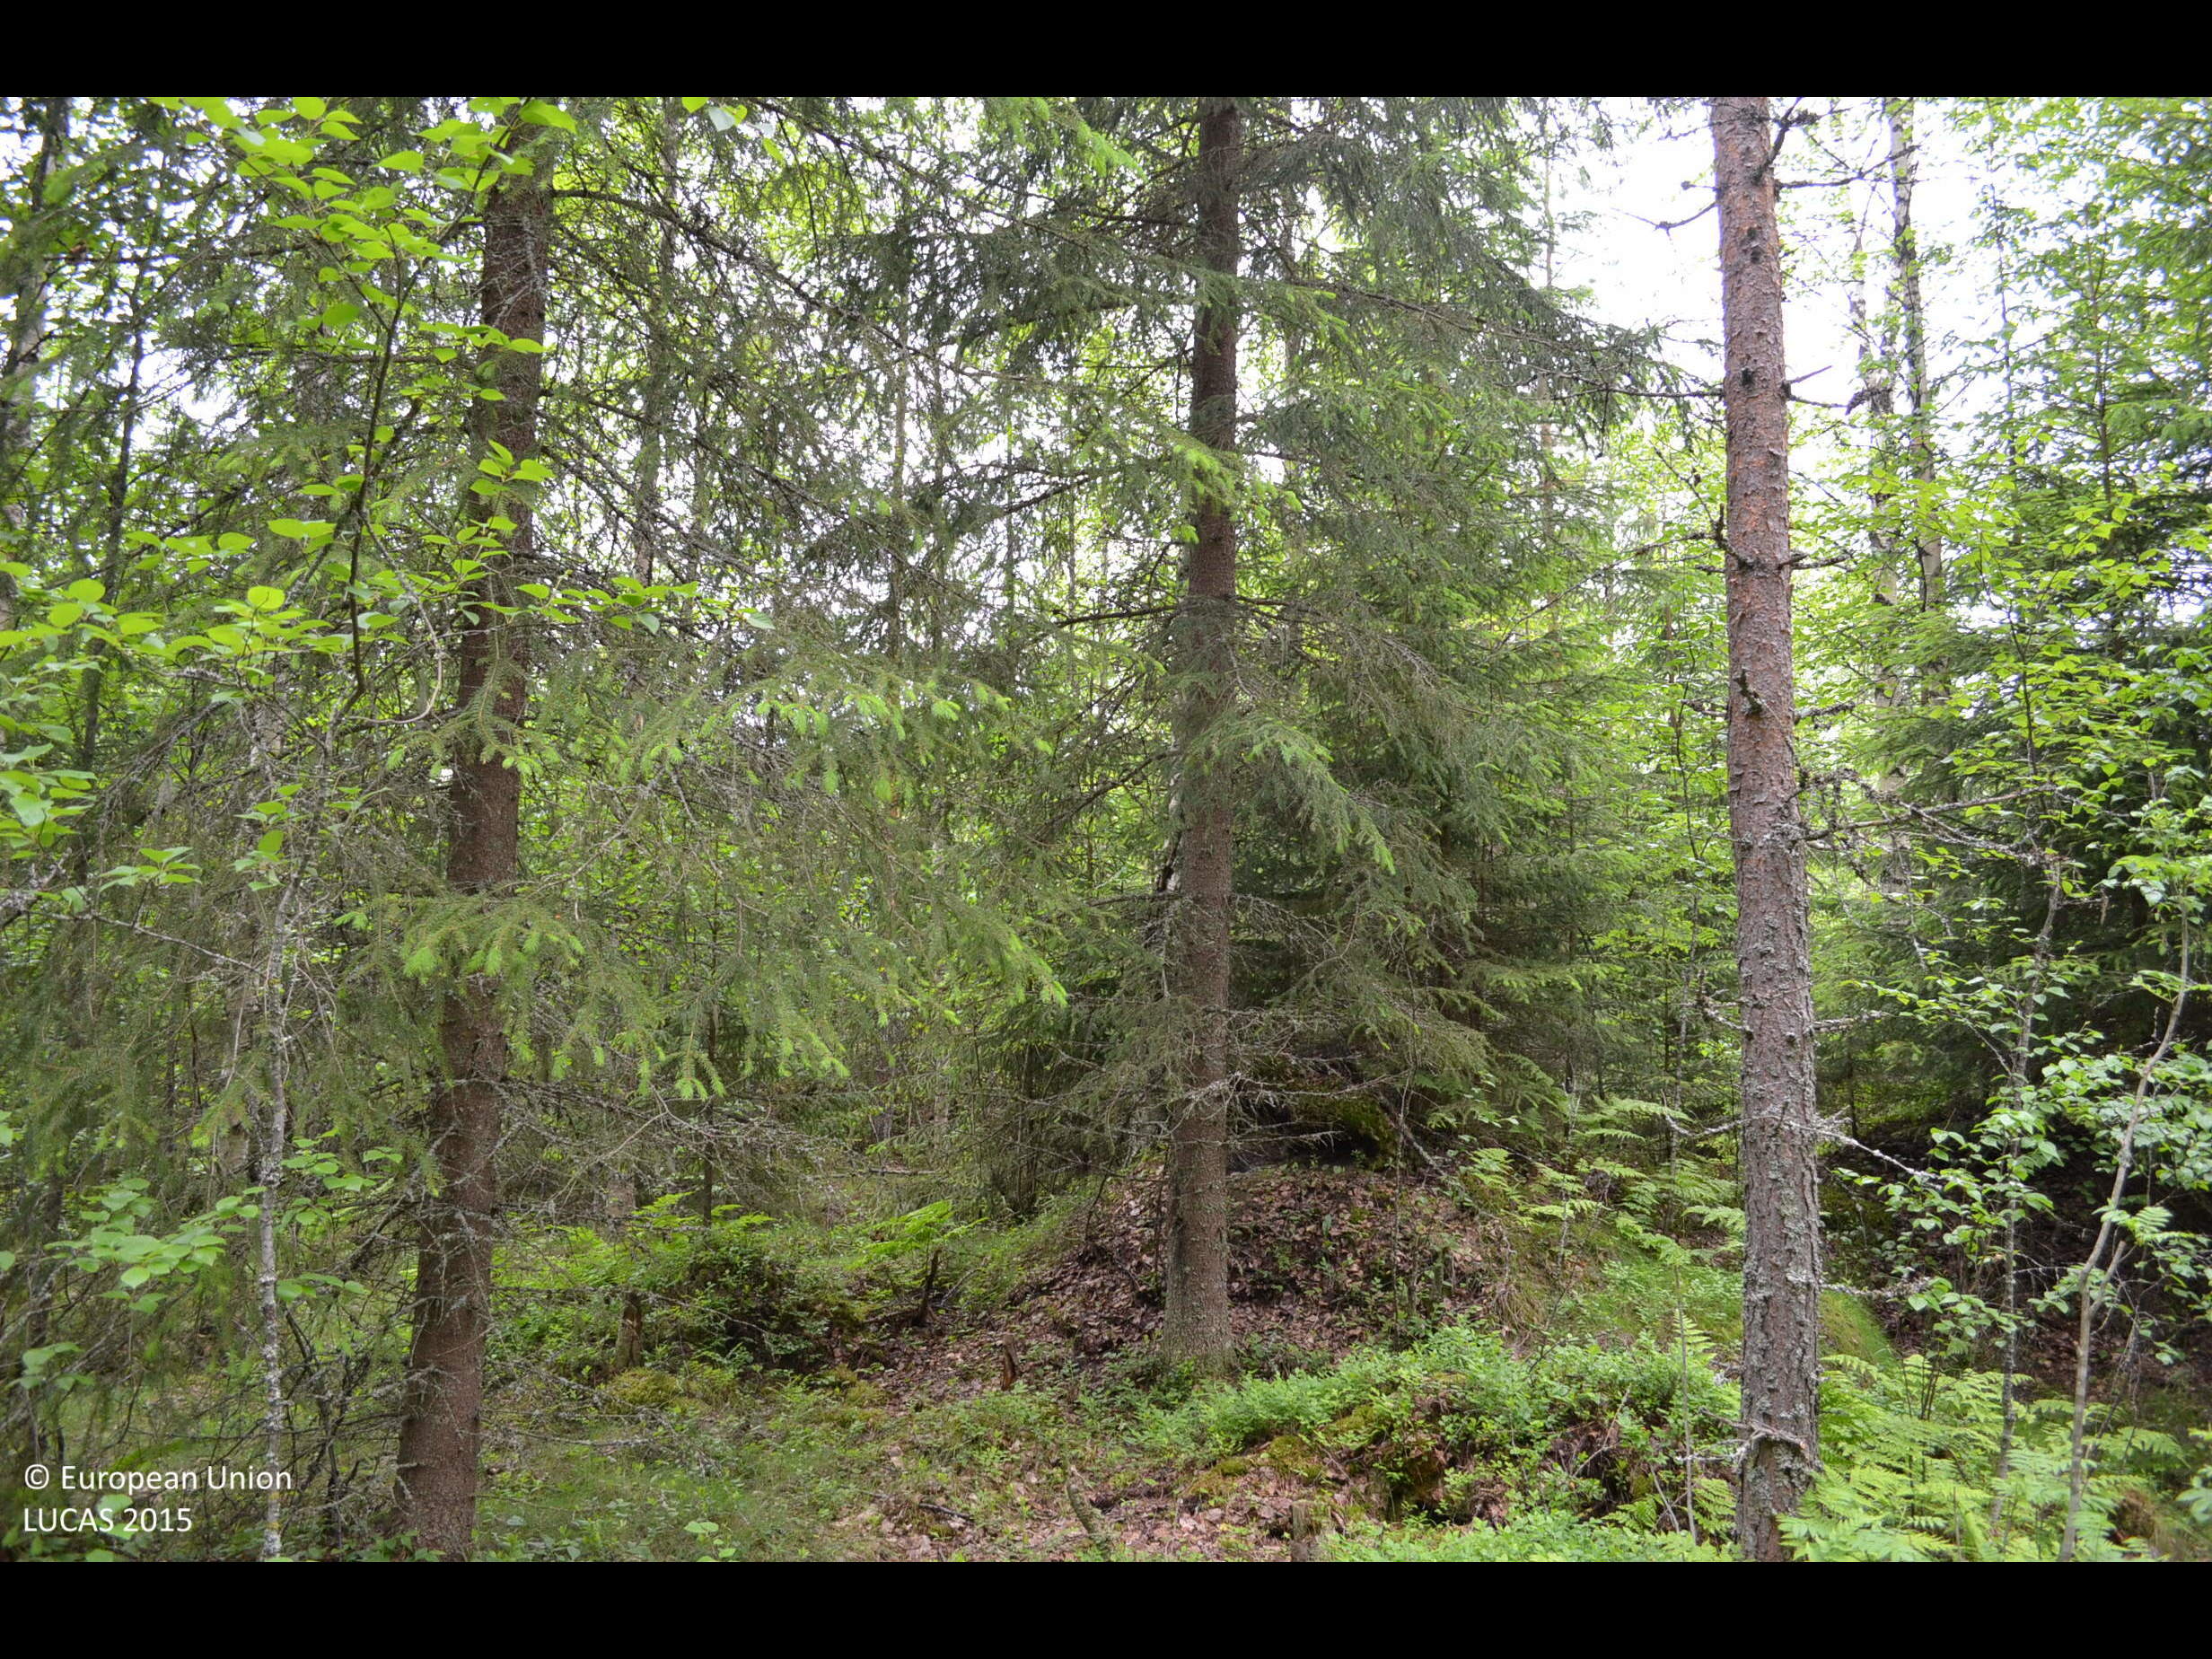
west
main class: Woodland
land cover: Other mixed woodland
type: boreal forest
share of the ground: > 75 %
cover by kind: broadleaved forest trees 45 %, coniferous forest trees 35 %, shrubs 20 %
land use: Forestry
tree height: > 5 m
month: June
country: FI
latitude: 61.7104
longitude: 23.0647
